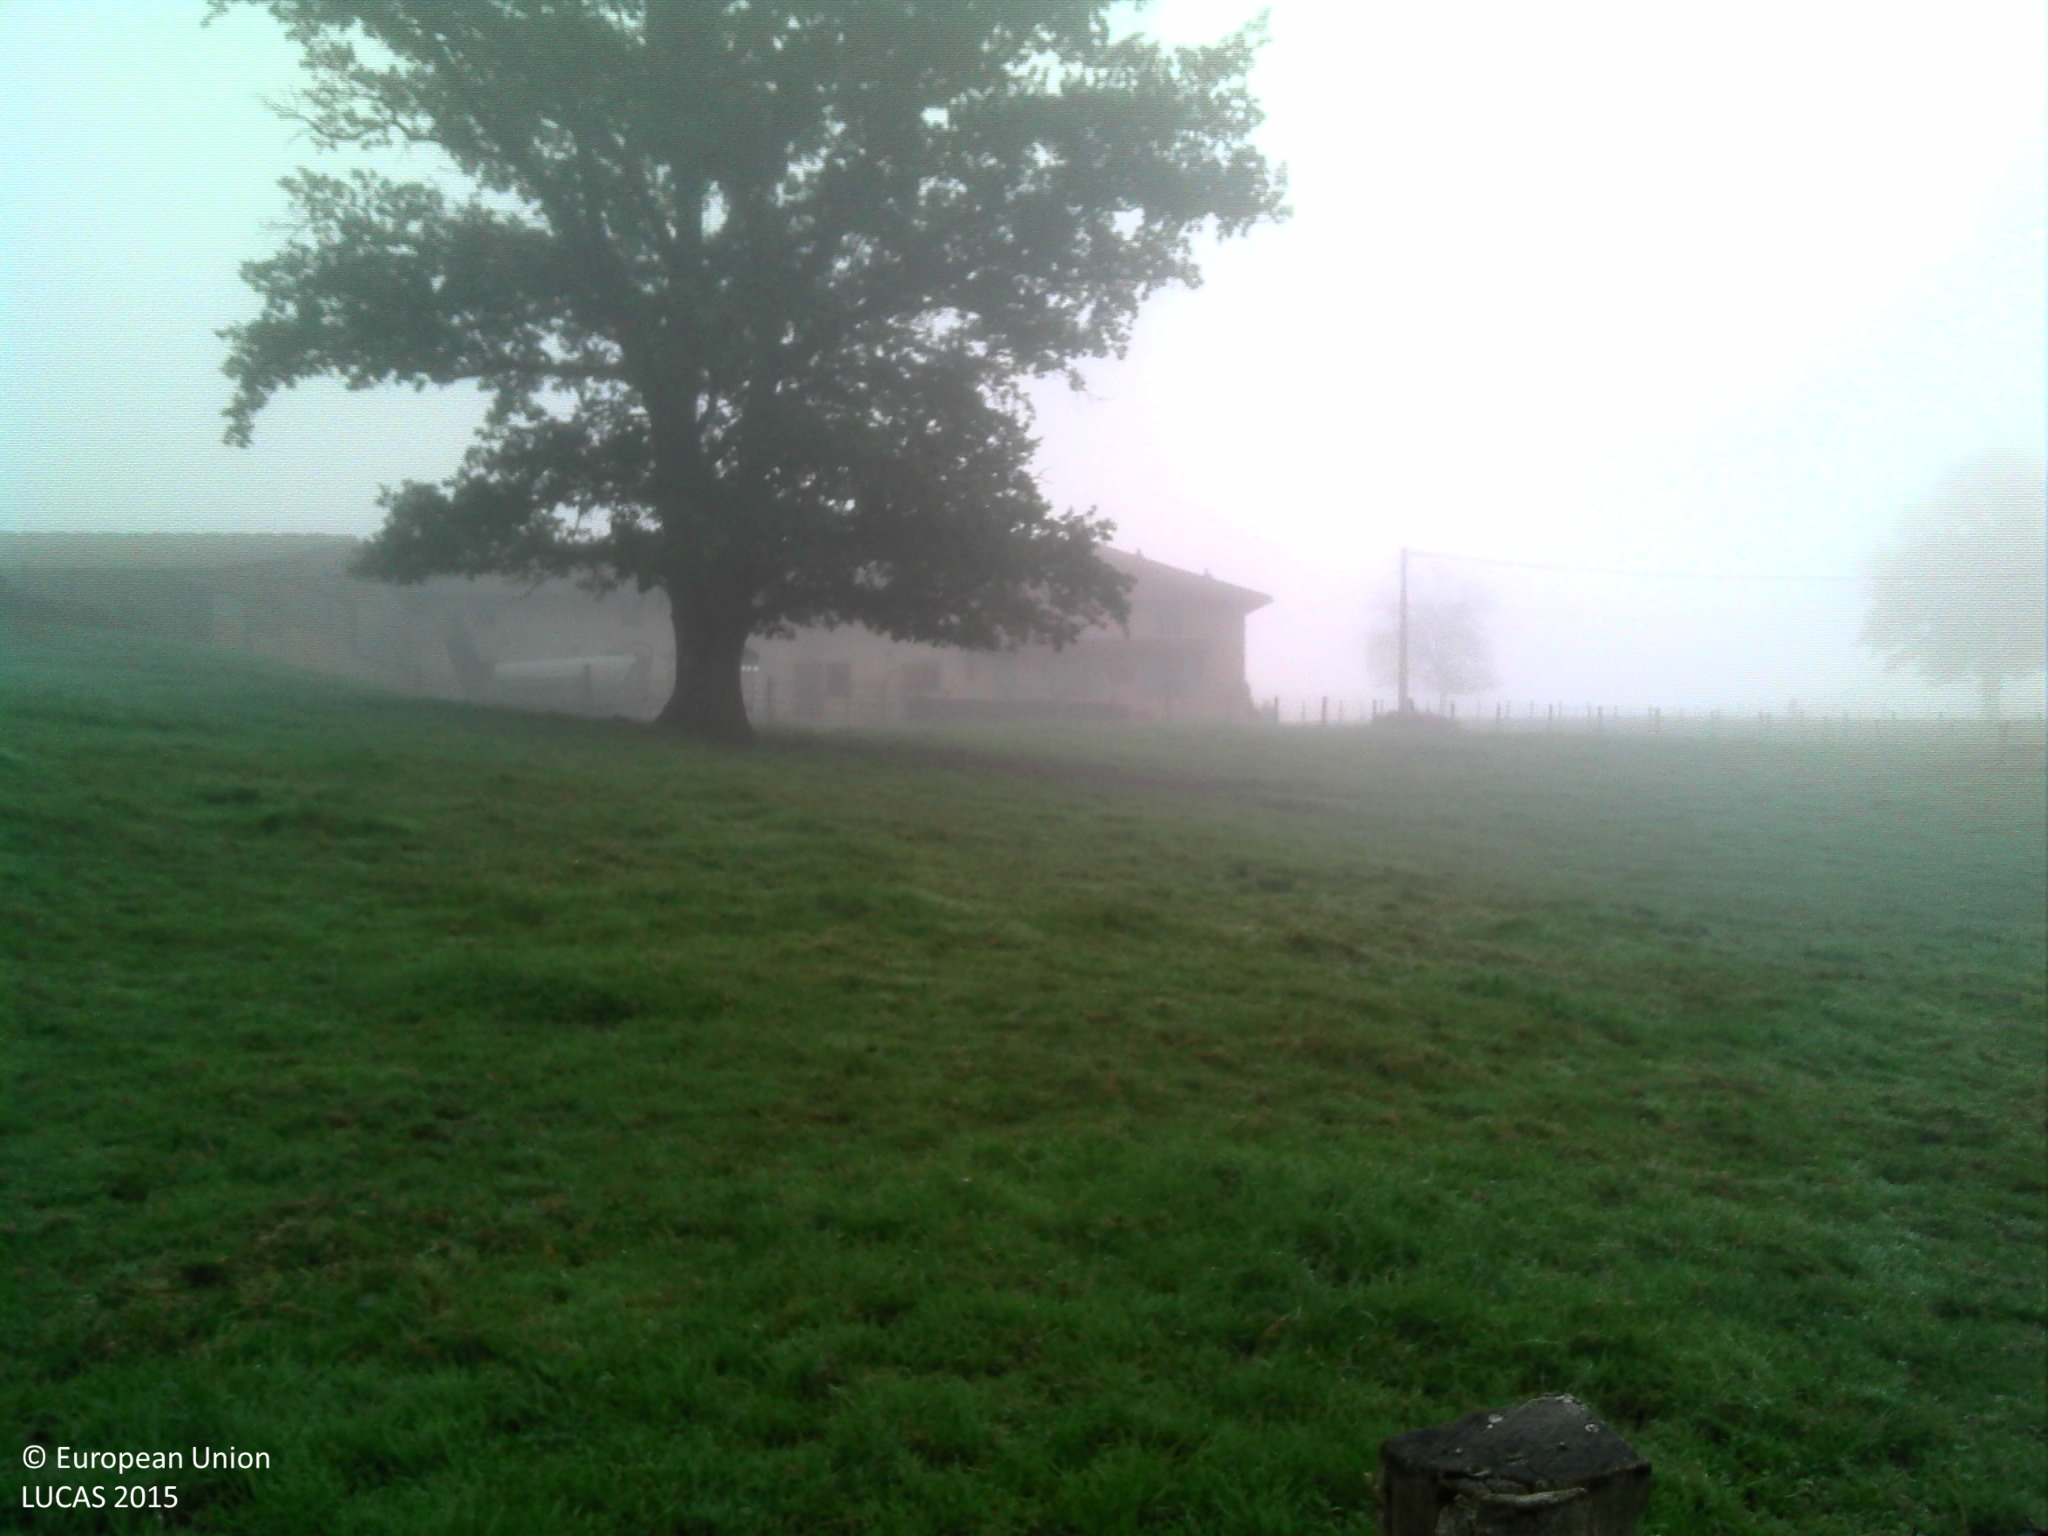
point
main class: Grassland
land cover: Grassland without tree/shrub cover
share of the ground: > 75 %
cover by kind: herbaceous plants 100 %
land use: Agriculture (excluding fallow land and kitchen gardens)
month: October
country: FR
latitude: 46.3376
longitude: 5.2868
